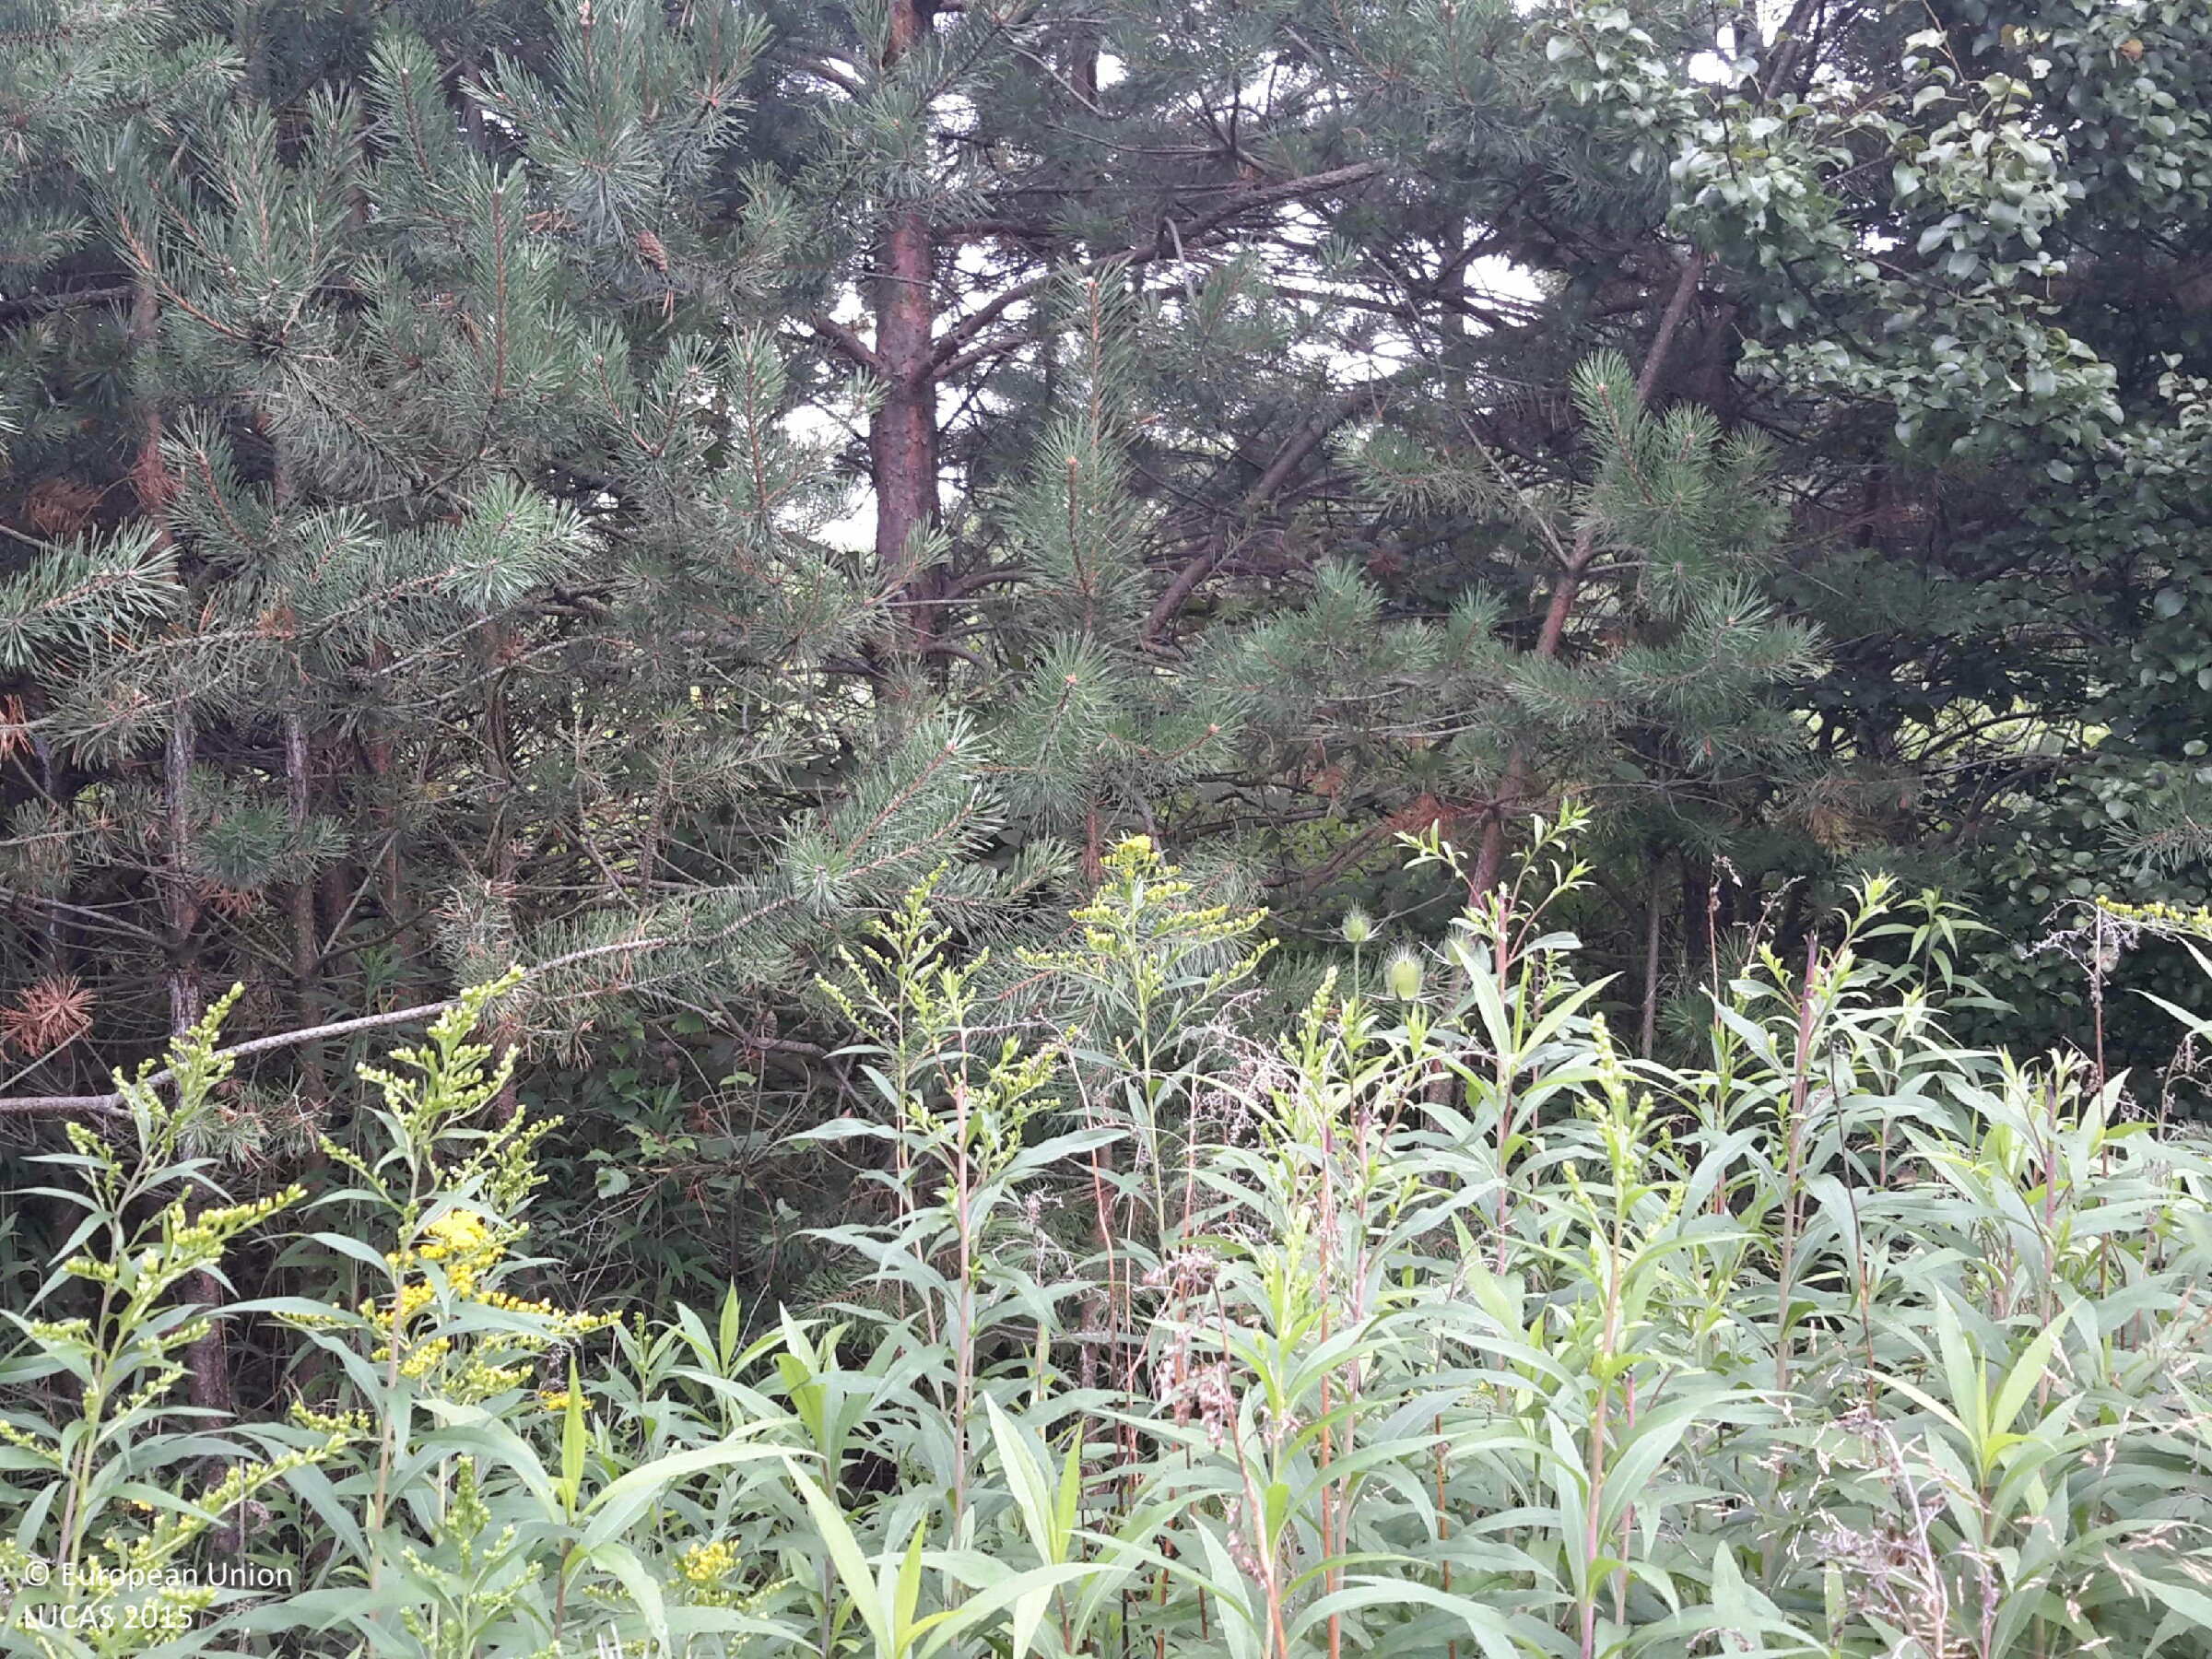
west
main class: Woodland
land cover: Pine dominated coniferous woodland
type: hemiboreal forest and nemoral coniferous forest and mixed broadleaved-coniferous forest
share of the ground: 25 - 50 %
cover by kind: coniferous forest trees 50 %, herbaceous plants 40 %, broadleaved forest trees 10 %
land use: Forestry
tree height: > 5 m
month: July
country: HU
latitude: 47.2020
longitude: 16.4846
